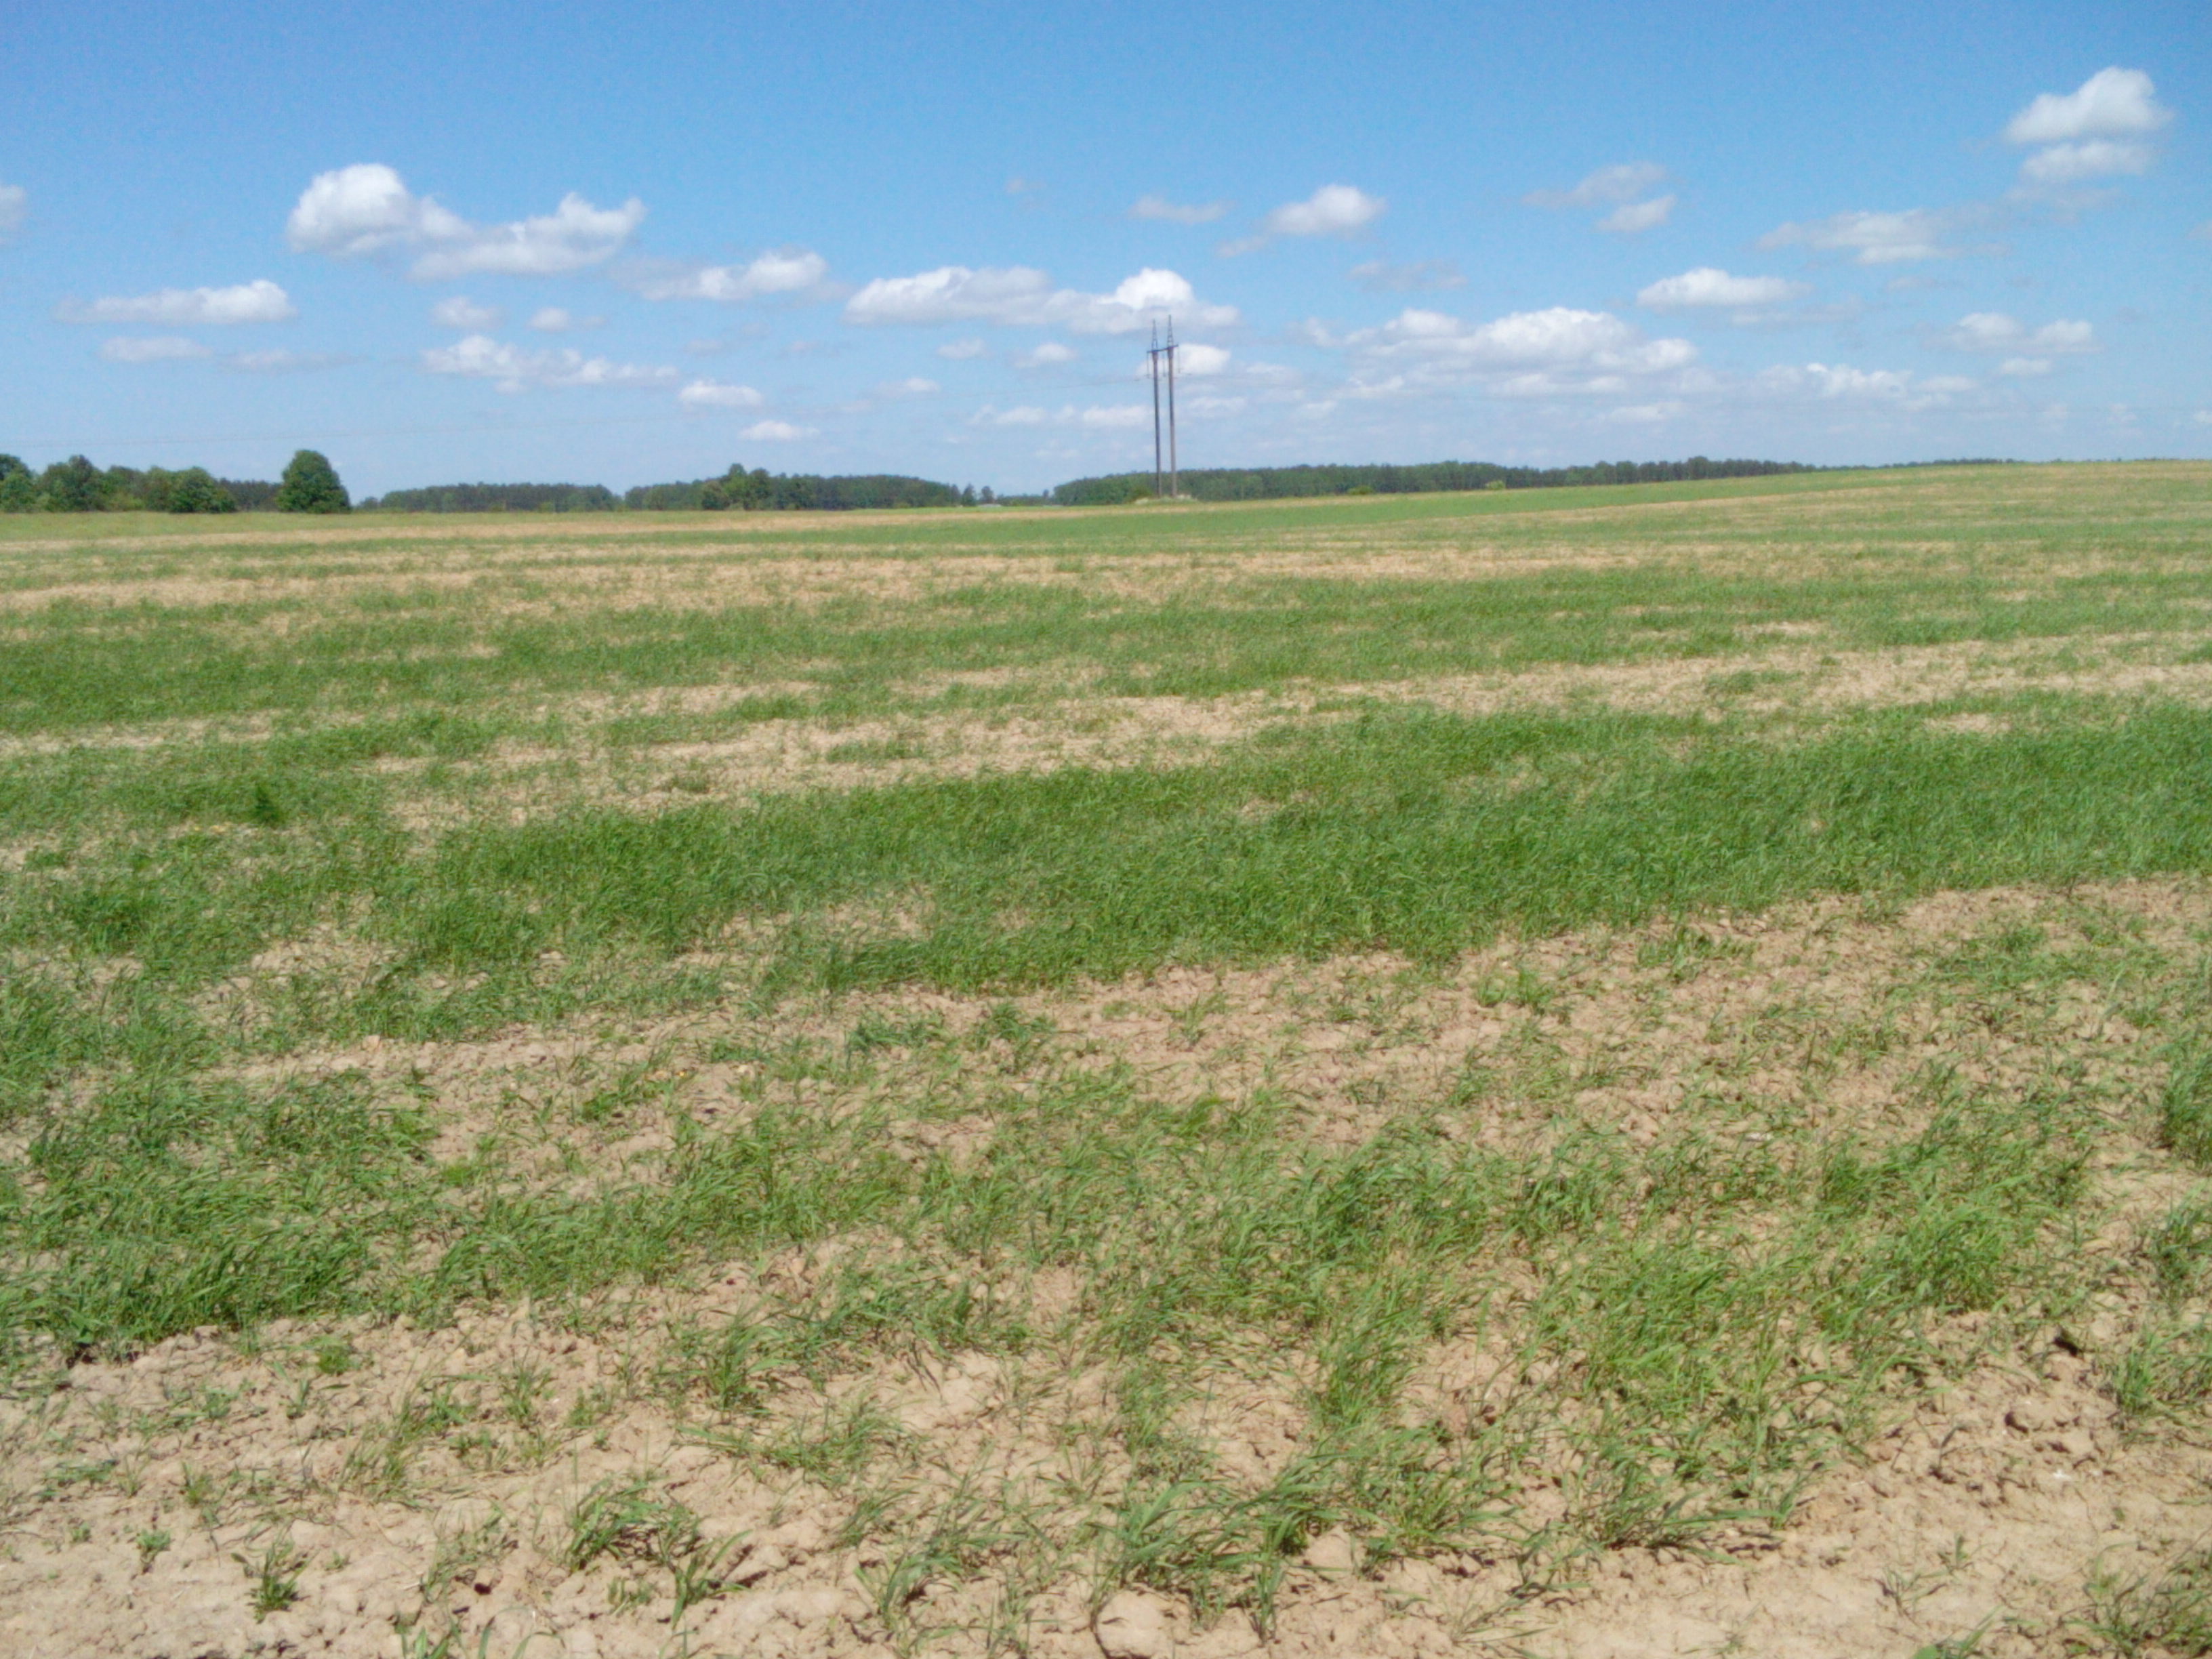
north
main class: Grassland
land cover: Spontaneously vegetated surfaces
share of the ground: < 10 %
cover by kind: unconsolidated bare surface 90 %, herbaceous plants 10 %
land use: Fallow land
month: June
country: LV
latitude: 56.6556
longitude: 22.2376
